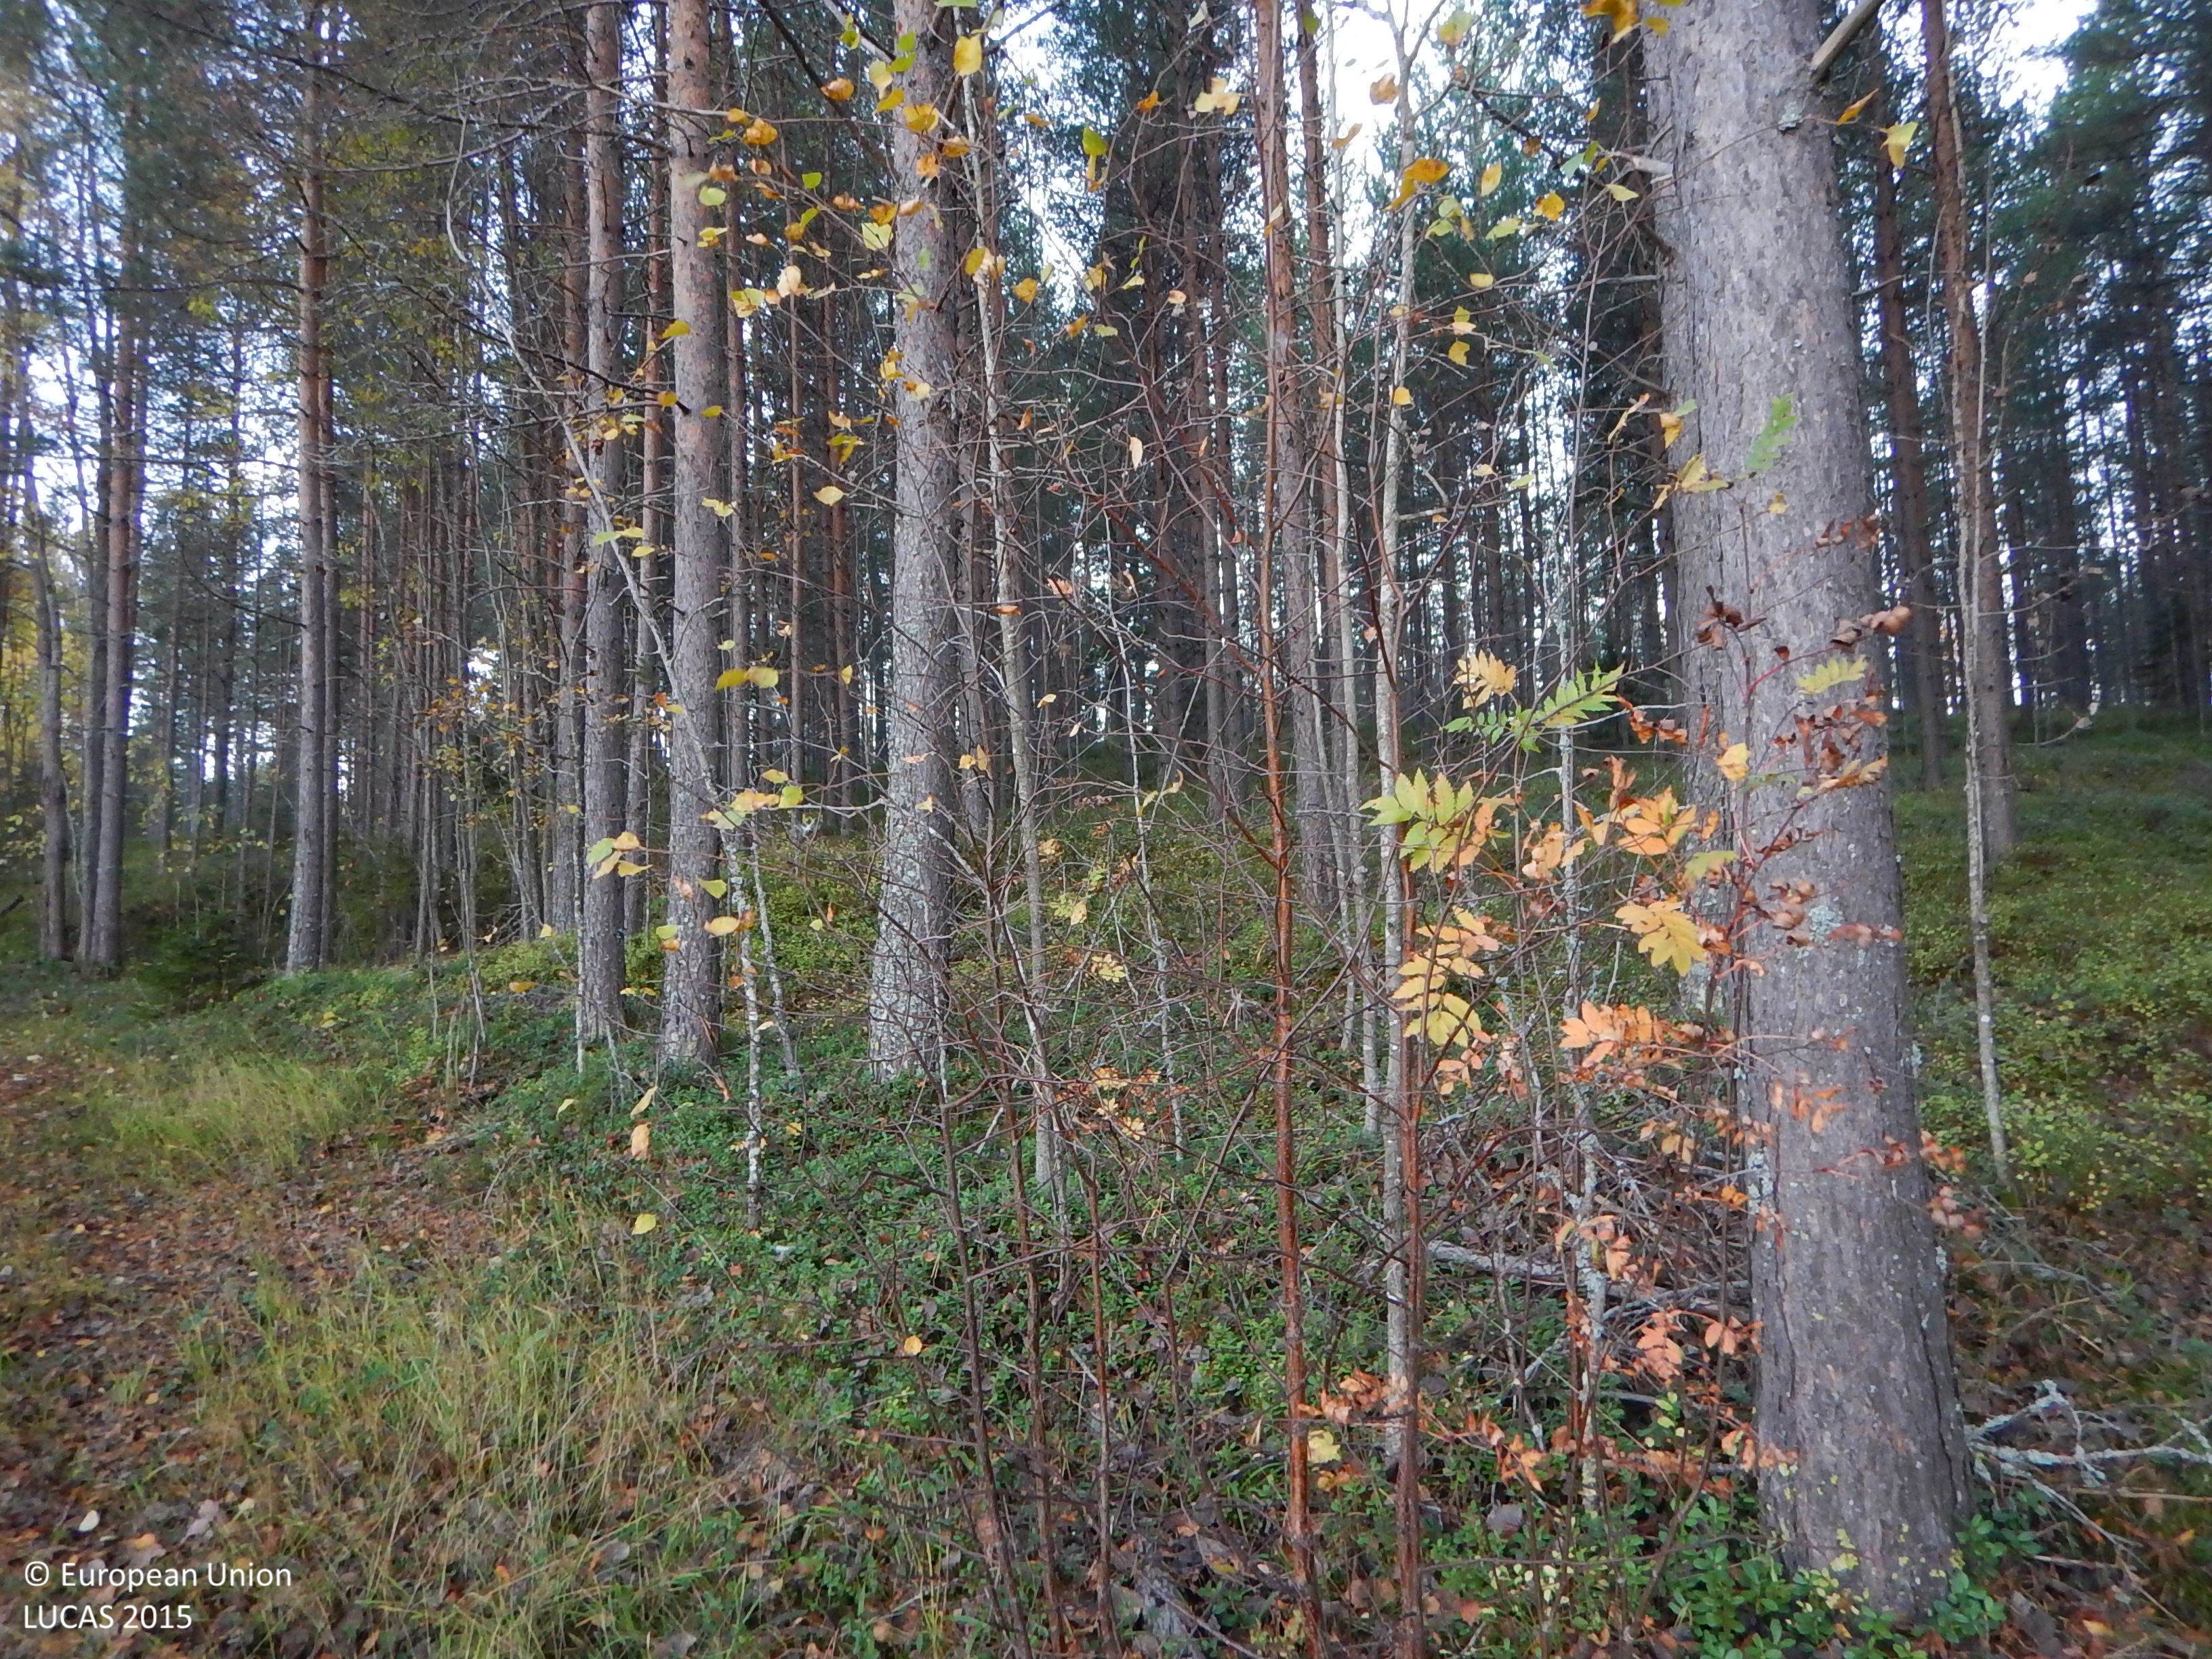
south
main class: Woodland
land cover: Pine dominated mixed woodland
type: boreal forest
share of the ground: 50 - 75 %
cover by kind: coniferous forest trees 40 %, broadleaved forest trees 20 %, shrubs 20 %, herbaceous plants 10 %, lichens and mosses 10 %
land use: Forestry
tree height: > 5 m
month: October
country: SE
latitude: 64.8876
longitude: 21.0643
